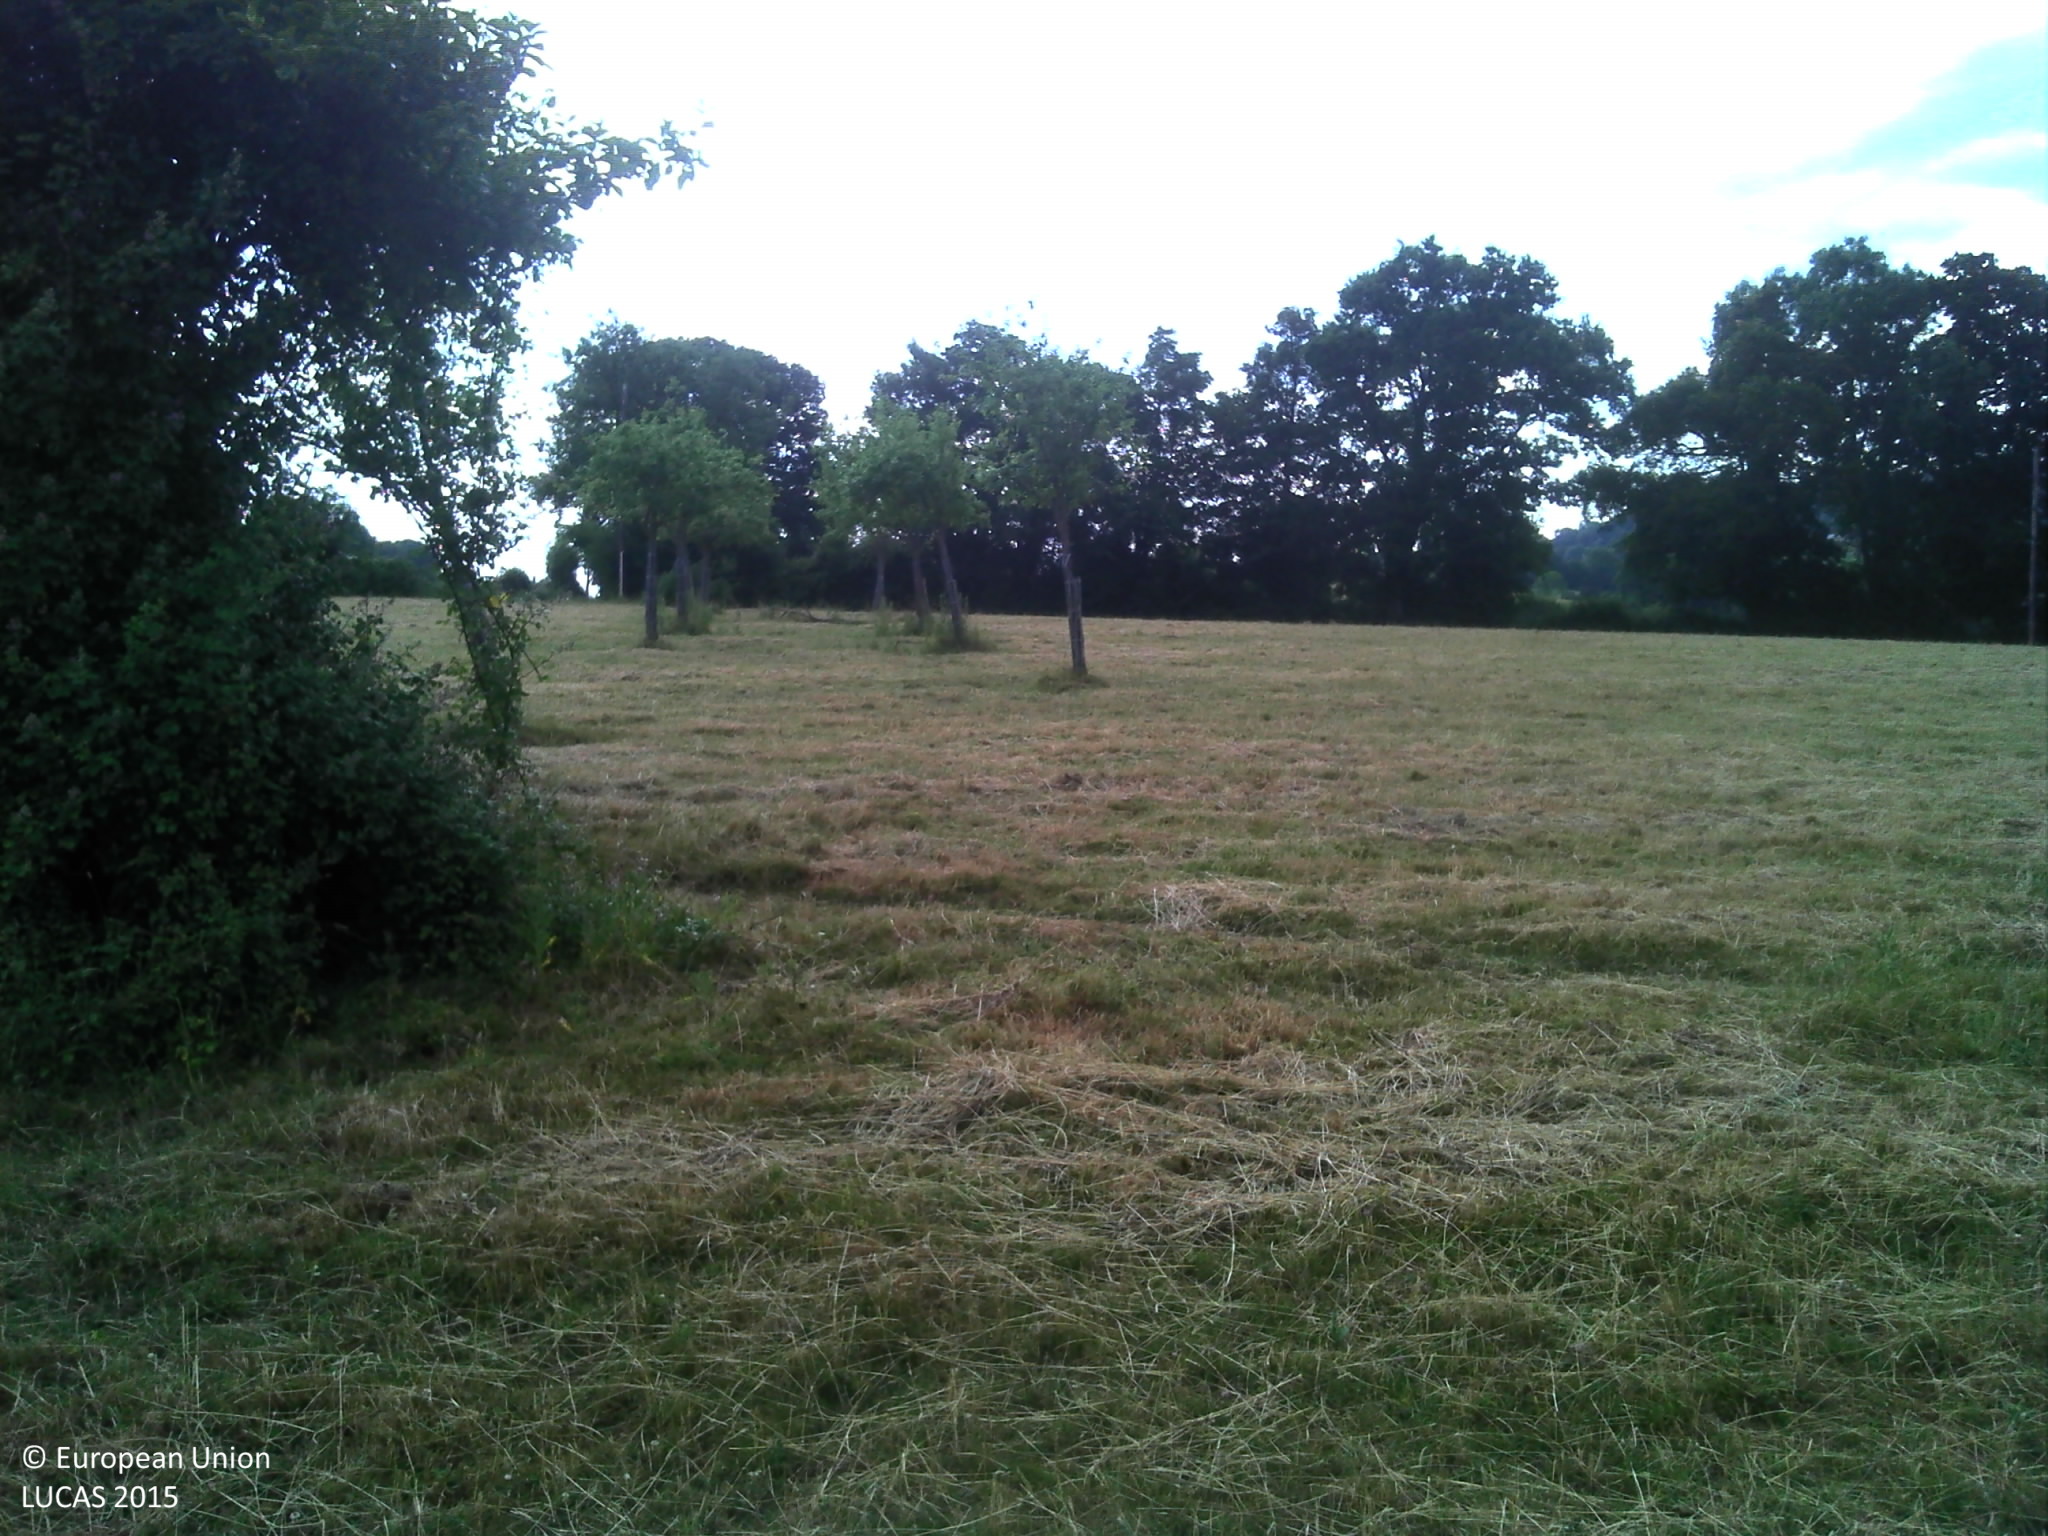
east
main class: Cropland
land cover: Apple fruit
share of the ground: 10 - 25 %
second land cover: Grassland without tree/shrub cover
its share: > 75 %
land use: Agriculture (excluding fallow land and kitchen gardens)
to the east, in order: Apple fruit; Grassland without tree/shrub cover; Electric lines; Broadleaved woodland; Grassland without tree/shrub cover; Fences; Broadleaved woodland; Grassland without tree/shrub cover
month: July
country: FR
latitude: 48.9499
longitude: 0.0425
